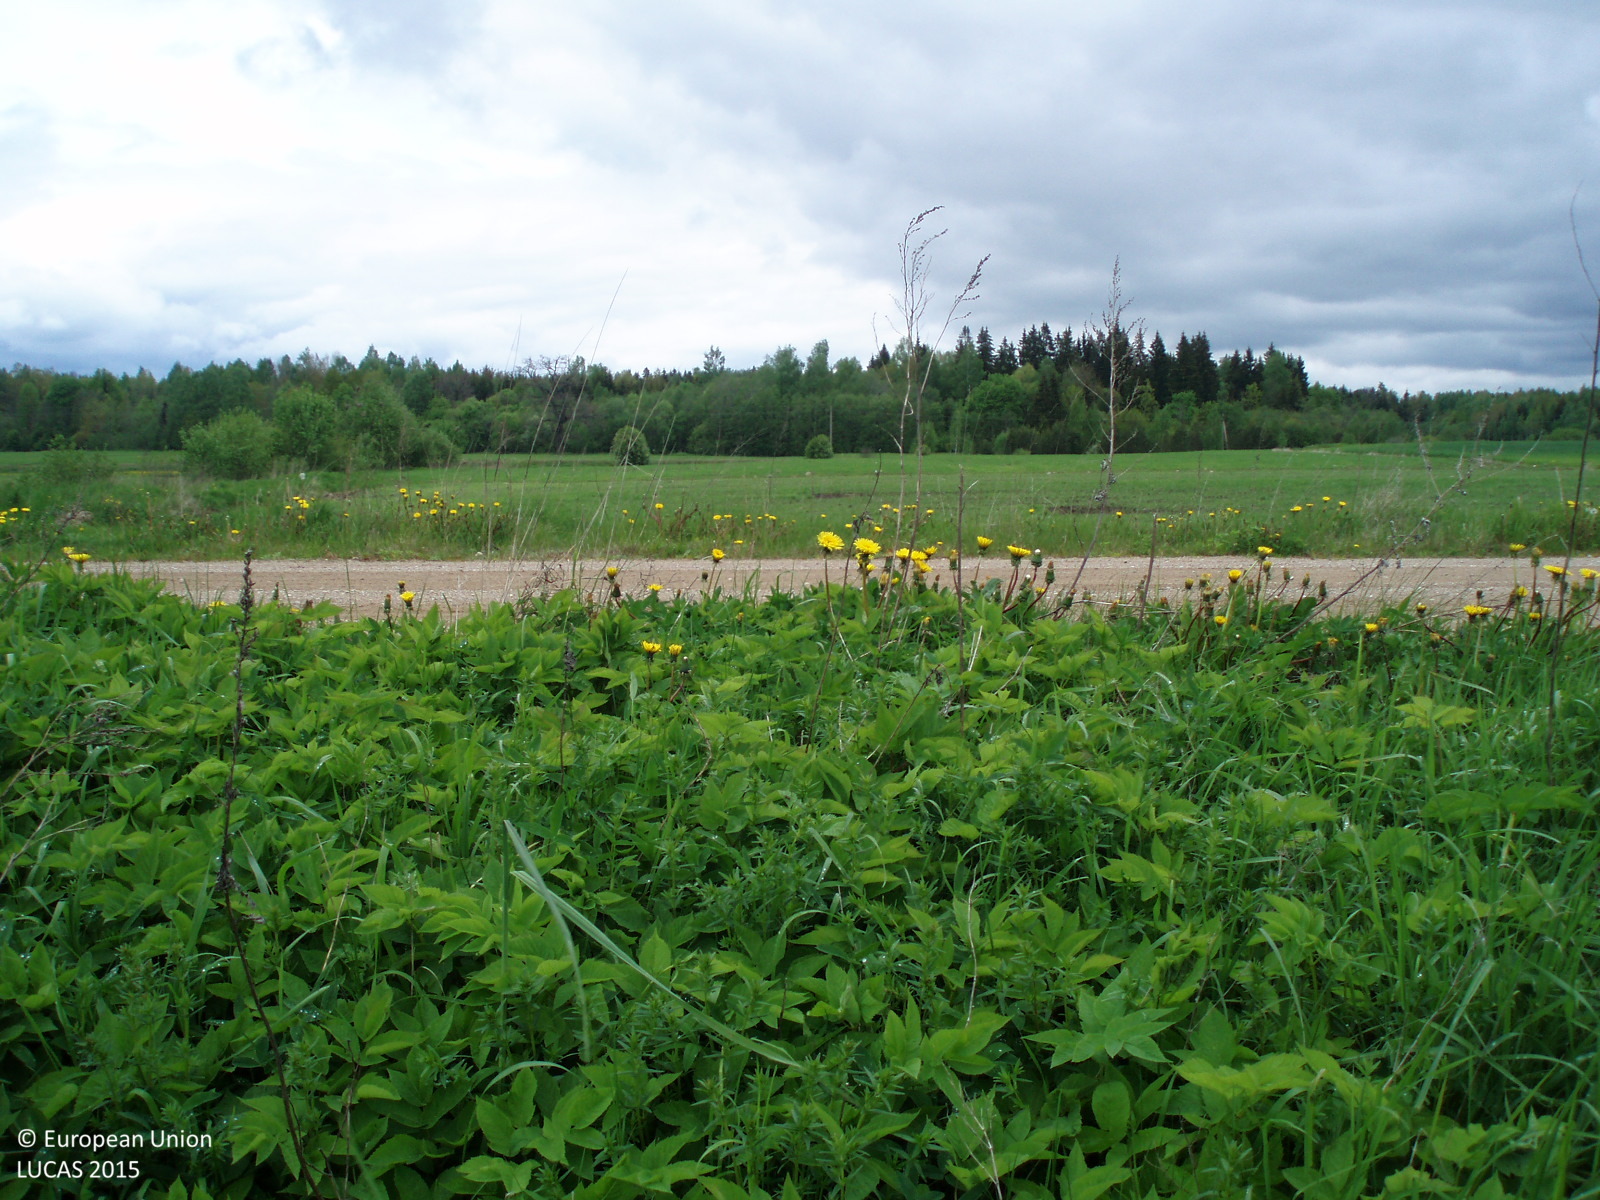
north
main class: Grassland
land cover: Grassland with sparse tree/shrub cover
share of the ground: > 75 %
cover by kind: herbaceous plants 90 %, broadleaved forest trees 5 %, shrubs 5 %
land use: Road transport
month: May
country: LT
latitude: 56.3182
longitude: 22.5239
